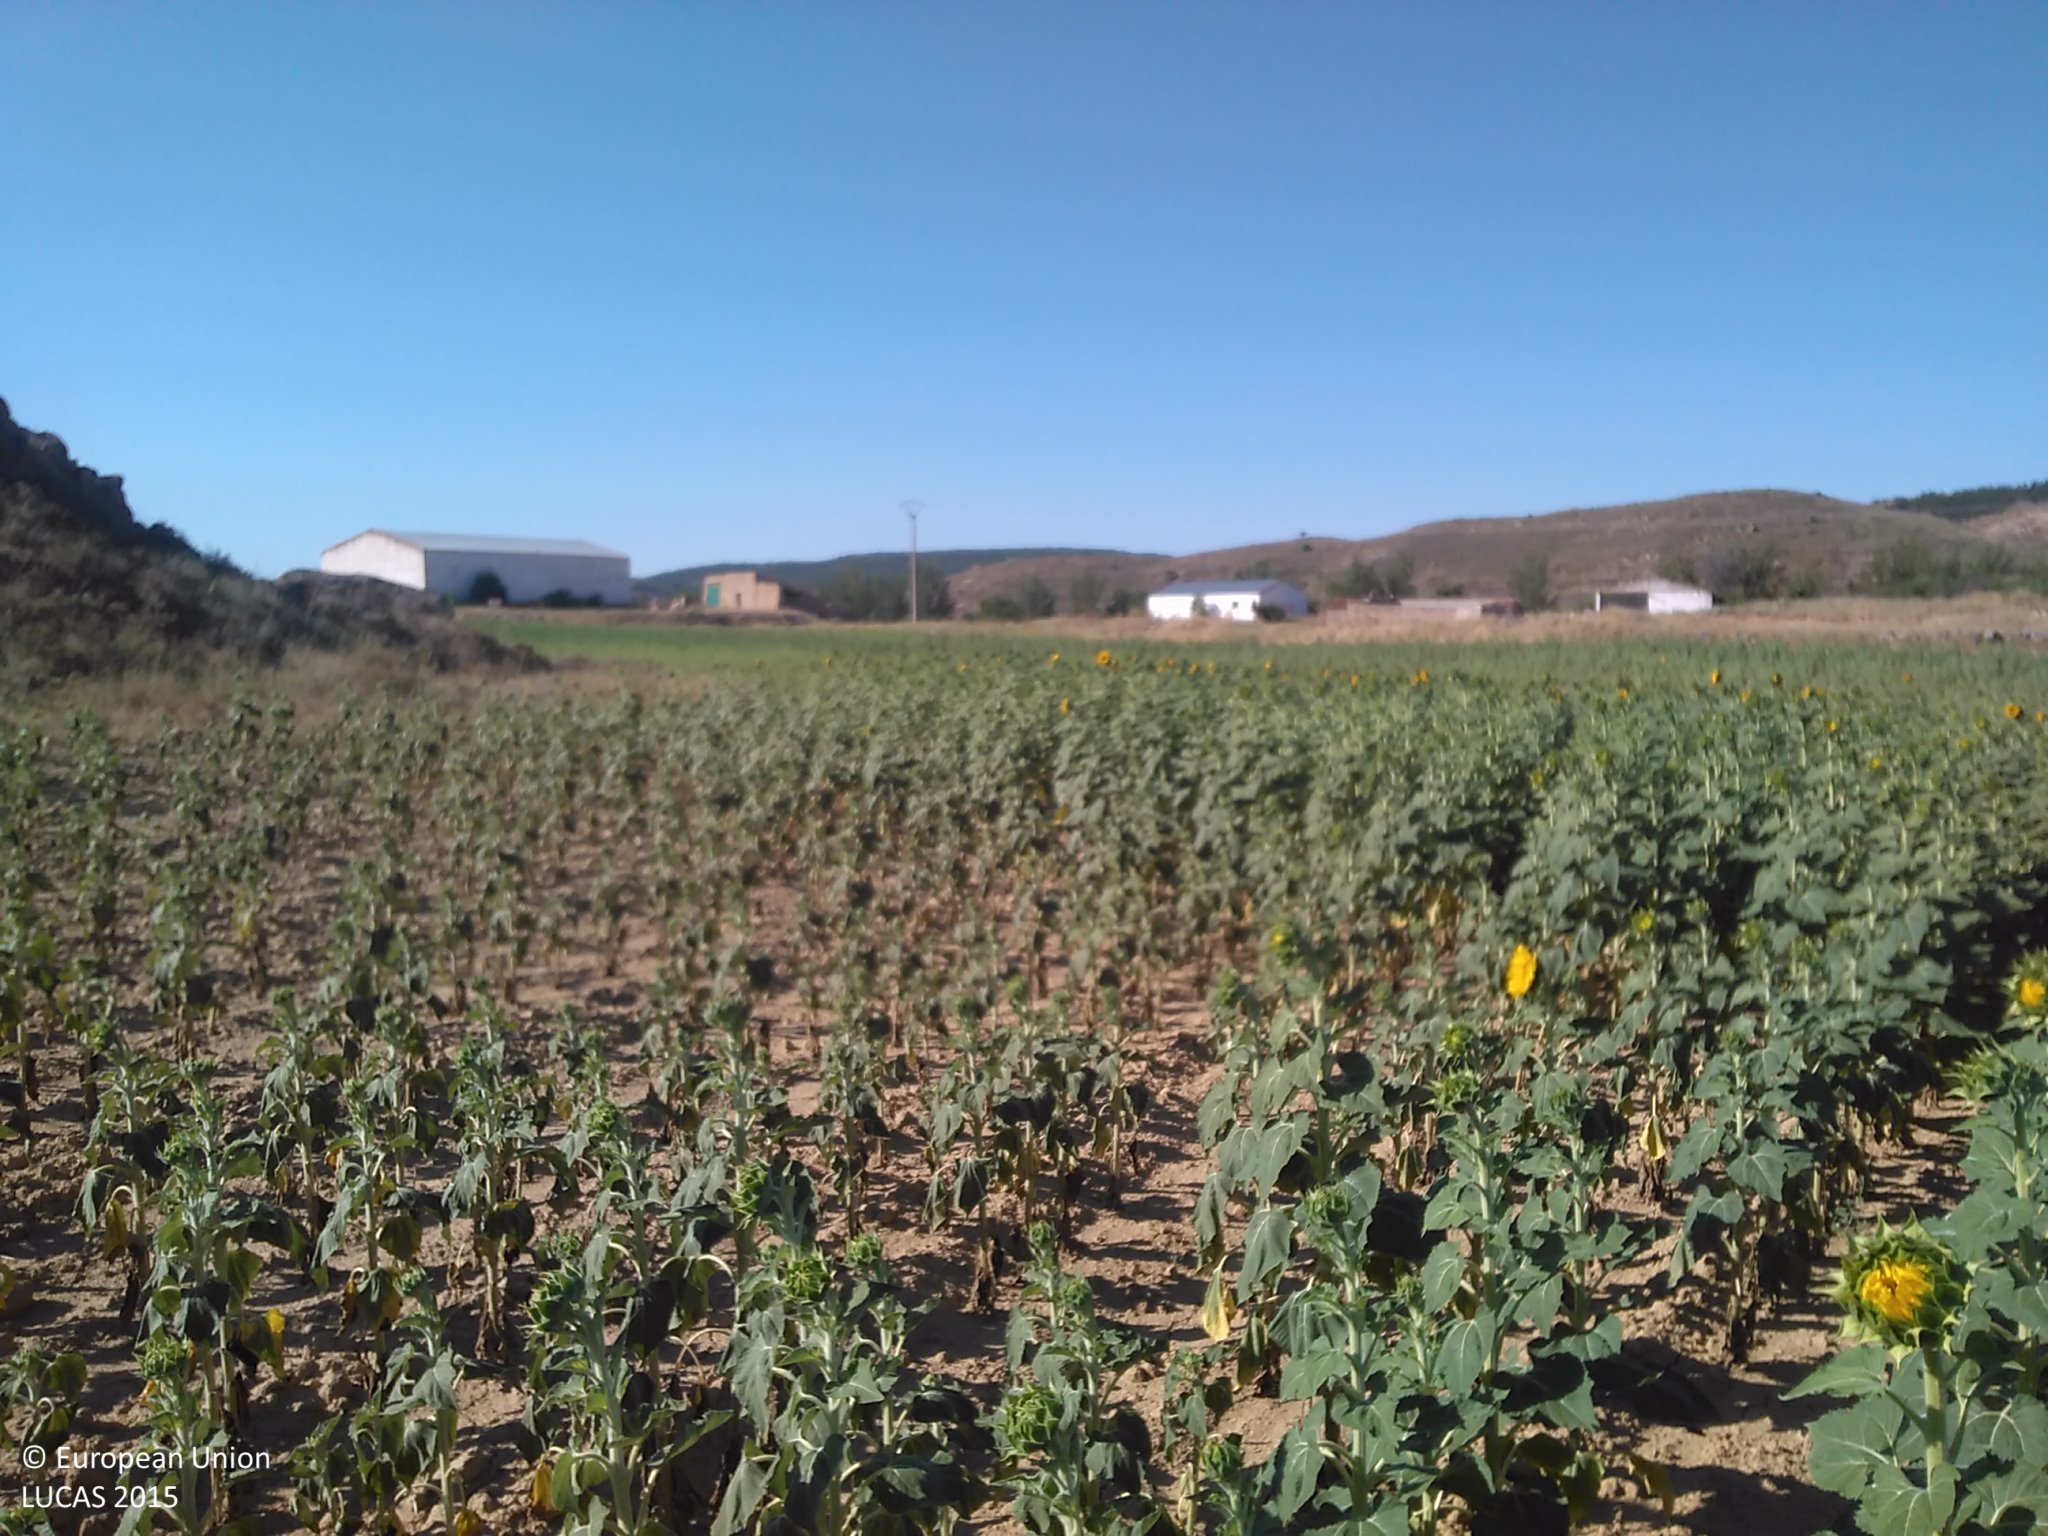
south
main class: Cropland
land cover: Sunflower
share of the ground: 50 - 75 %
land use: Agriculture (excluding fallow land and kitchen gardens)
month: July
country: ES
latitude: 41.5244
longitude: -2.0993
